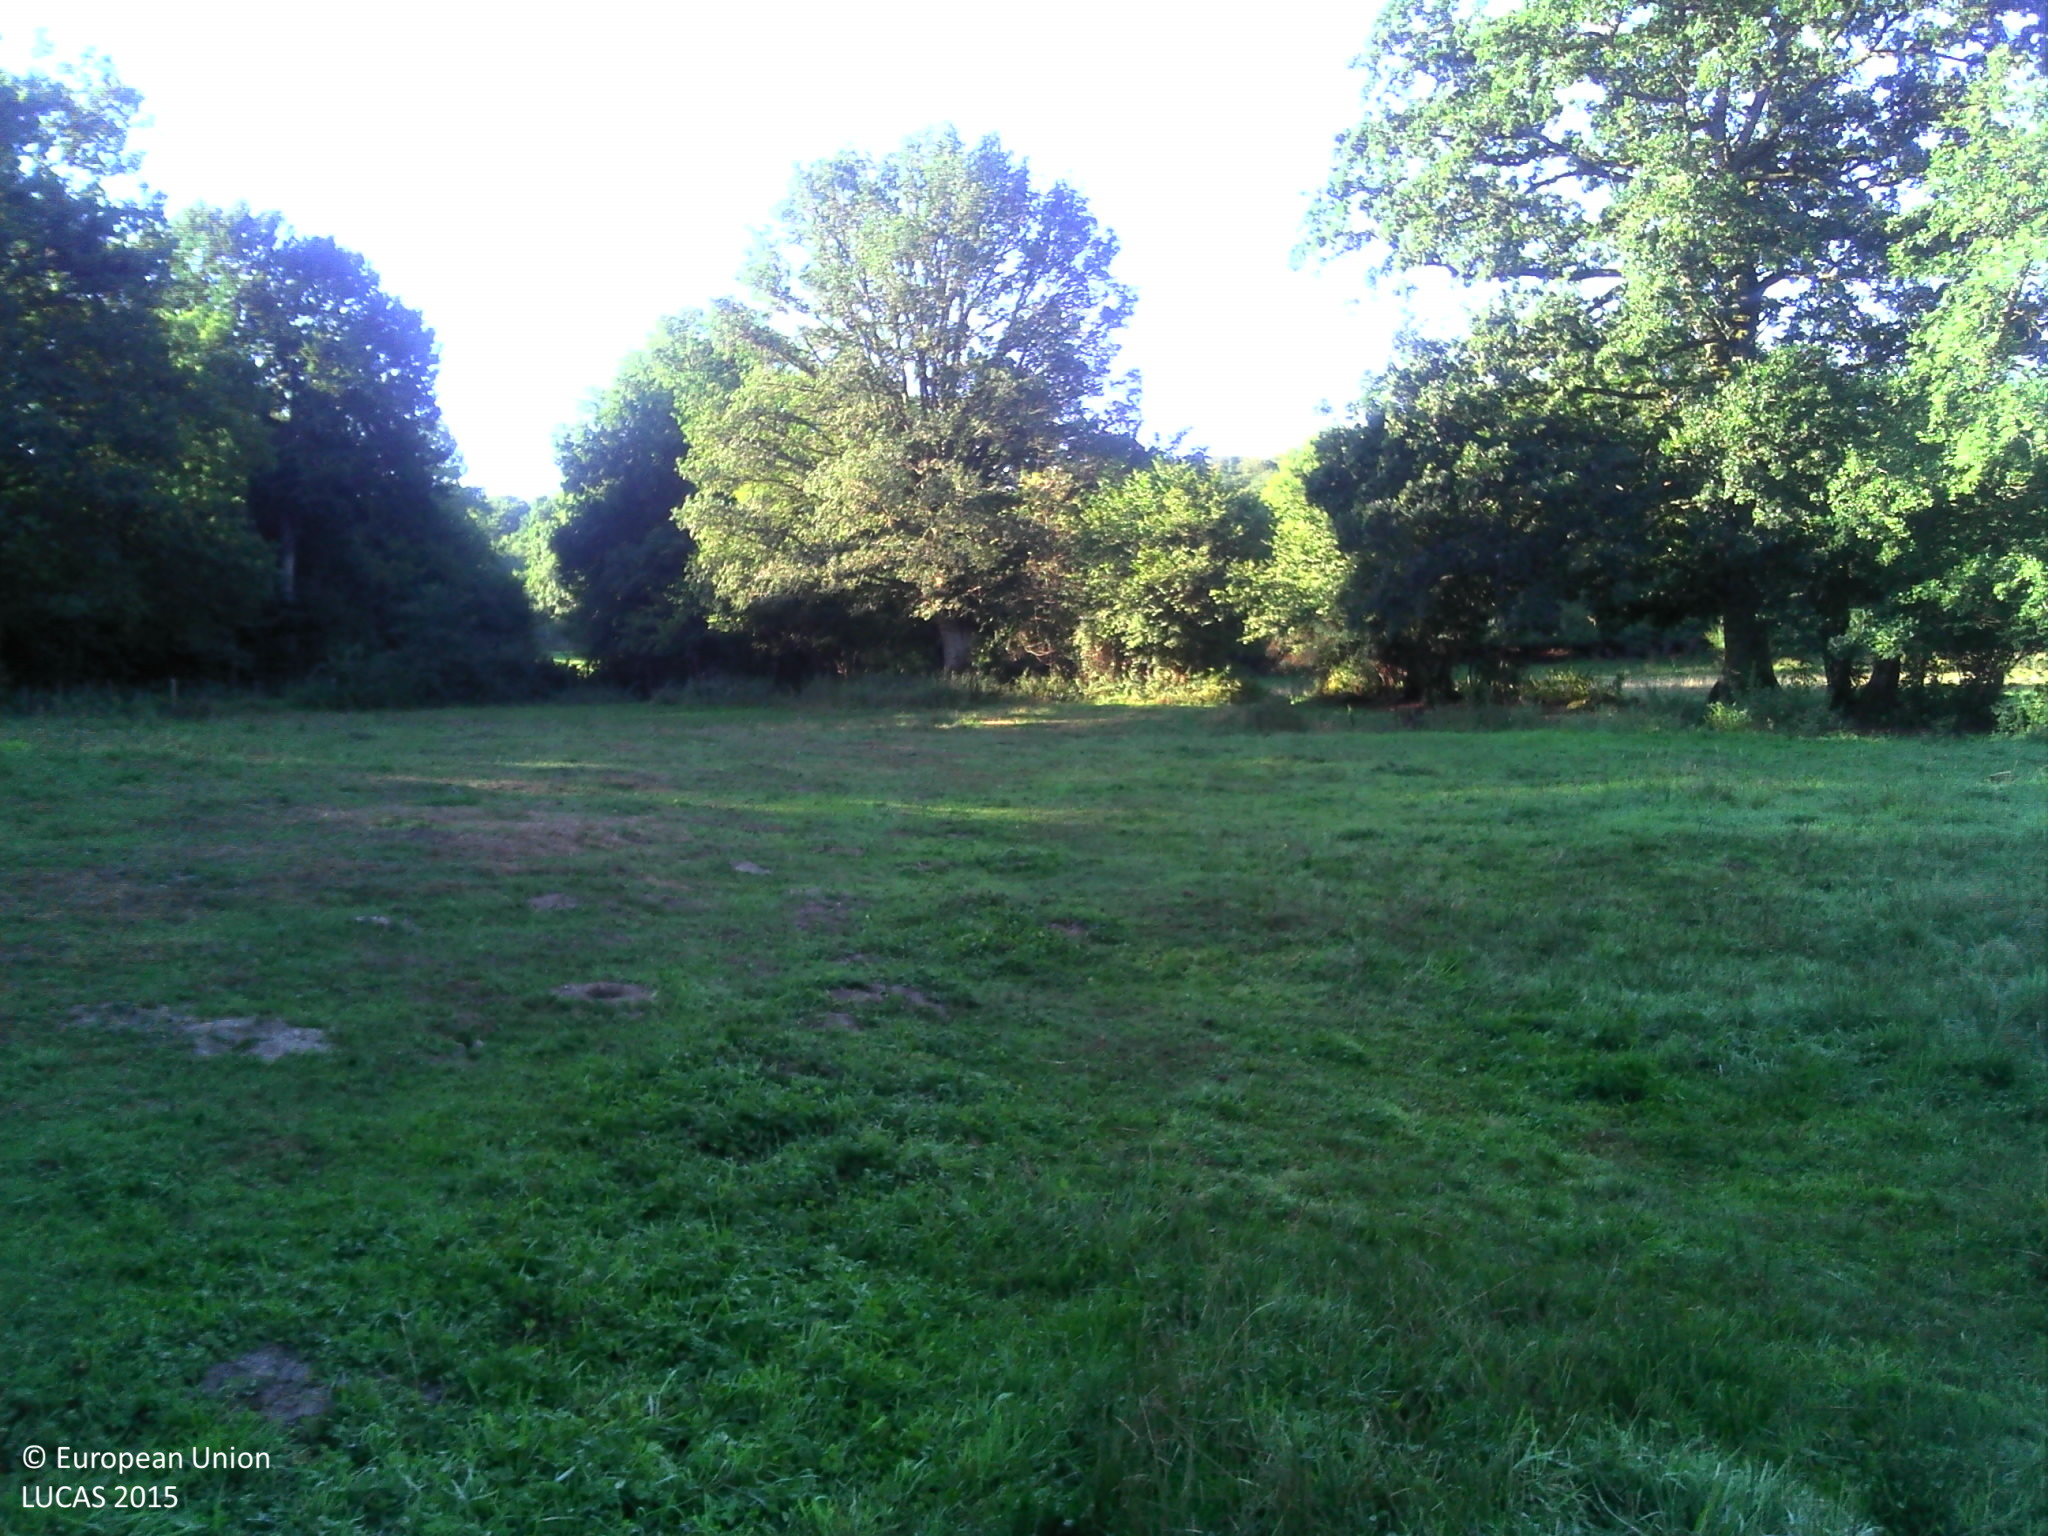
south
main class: Grassland
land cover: Grassland without tree/shrub cover
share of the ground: > 75 %
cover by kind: herbaceous plants 95 %, shrubs 5 %
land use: Agriculture (excluding fallow land and kitchen gardens)
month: August
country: FR
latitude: 45.8426
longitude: 2.3612
